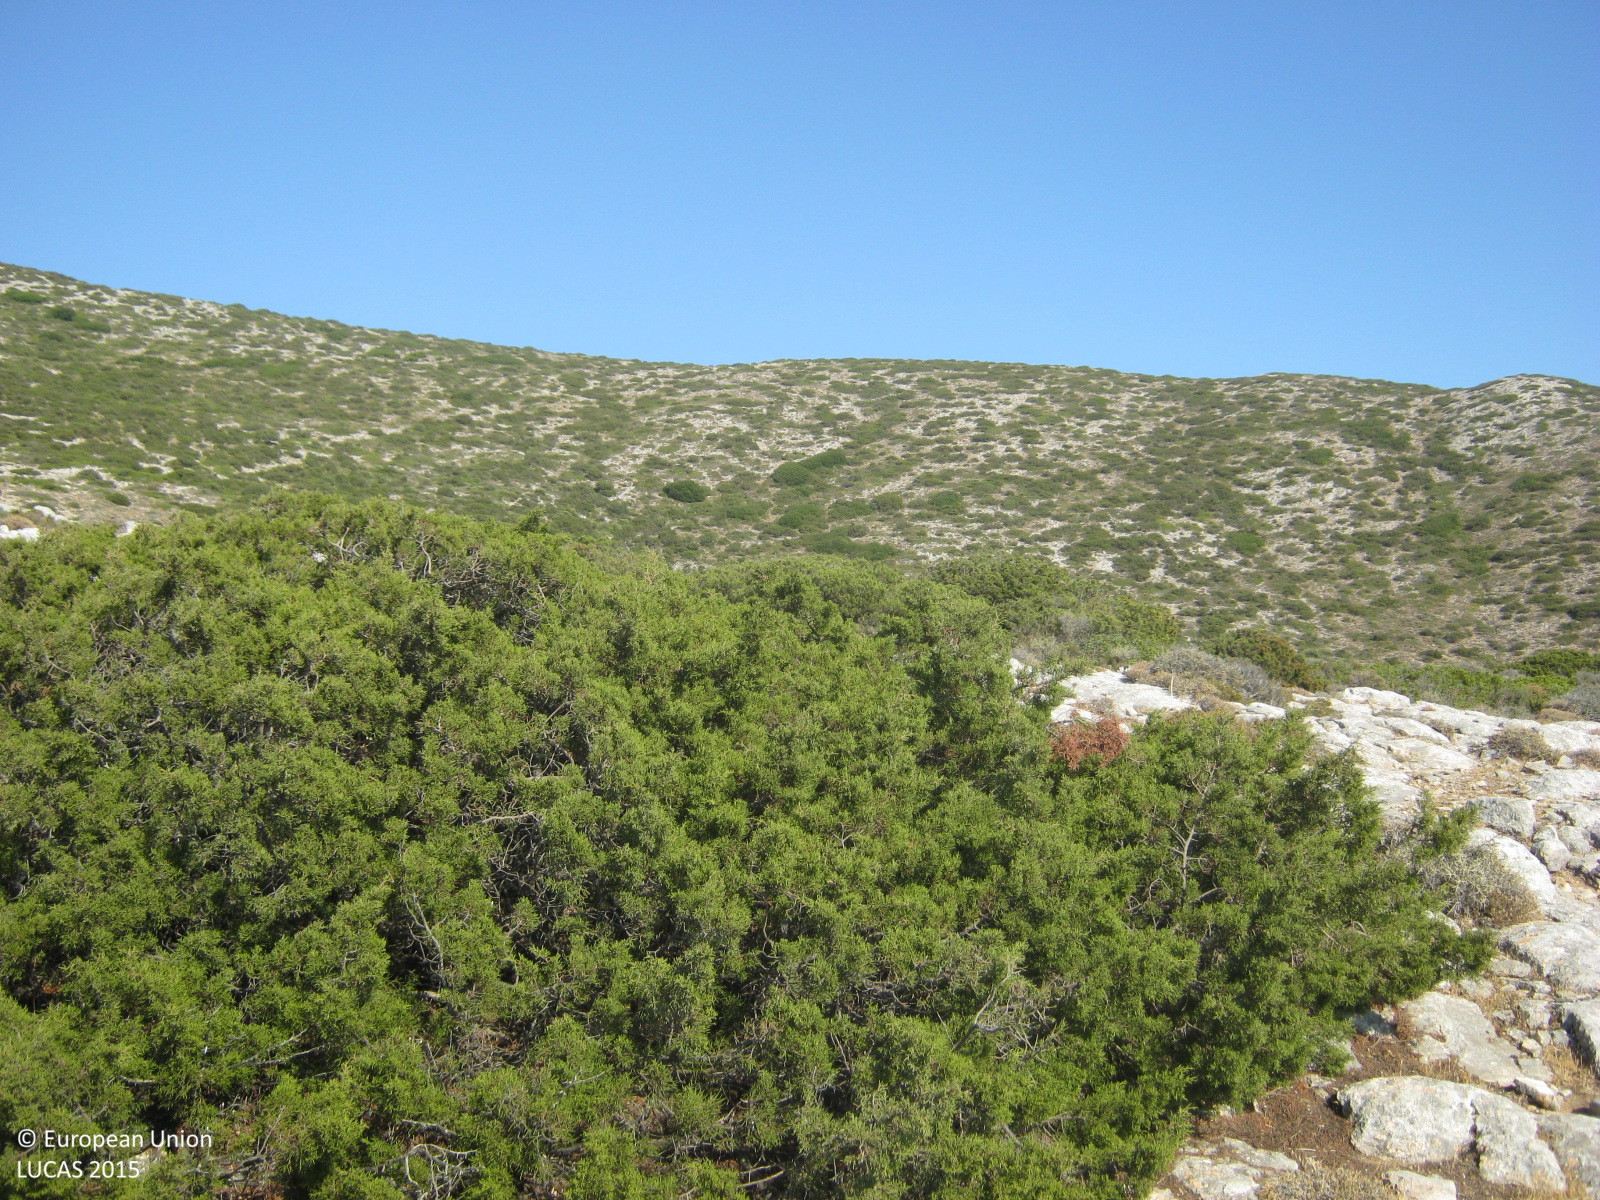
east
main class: Shrubland
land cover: Shrubland without tree cover
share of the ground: 50 - 75 %
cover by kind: shrubs 55 %, unconsolidated bare surface 40 %, herbaceous plants 5 %
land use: Agriculture (excluding fallow land and kitchen gardens)
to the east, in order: Shrubland without tree cover
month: August
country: GR
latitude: 37.0382
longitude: 25.1711
